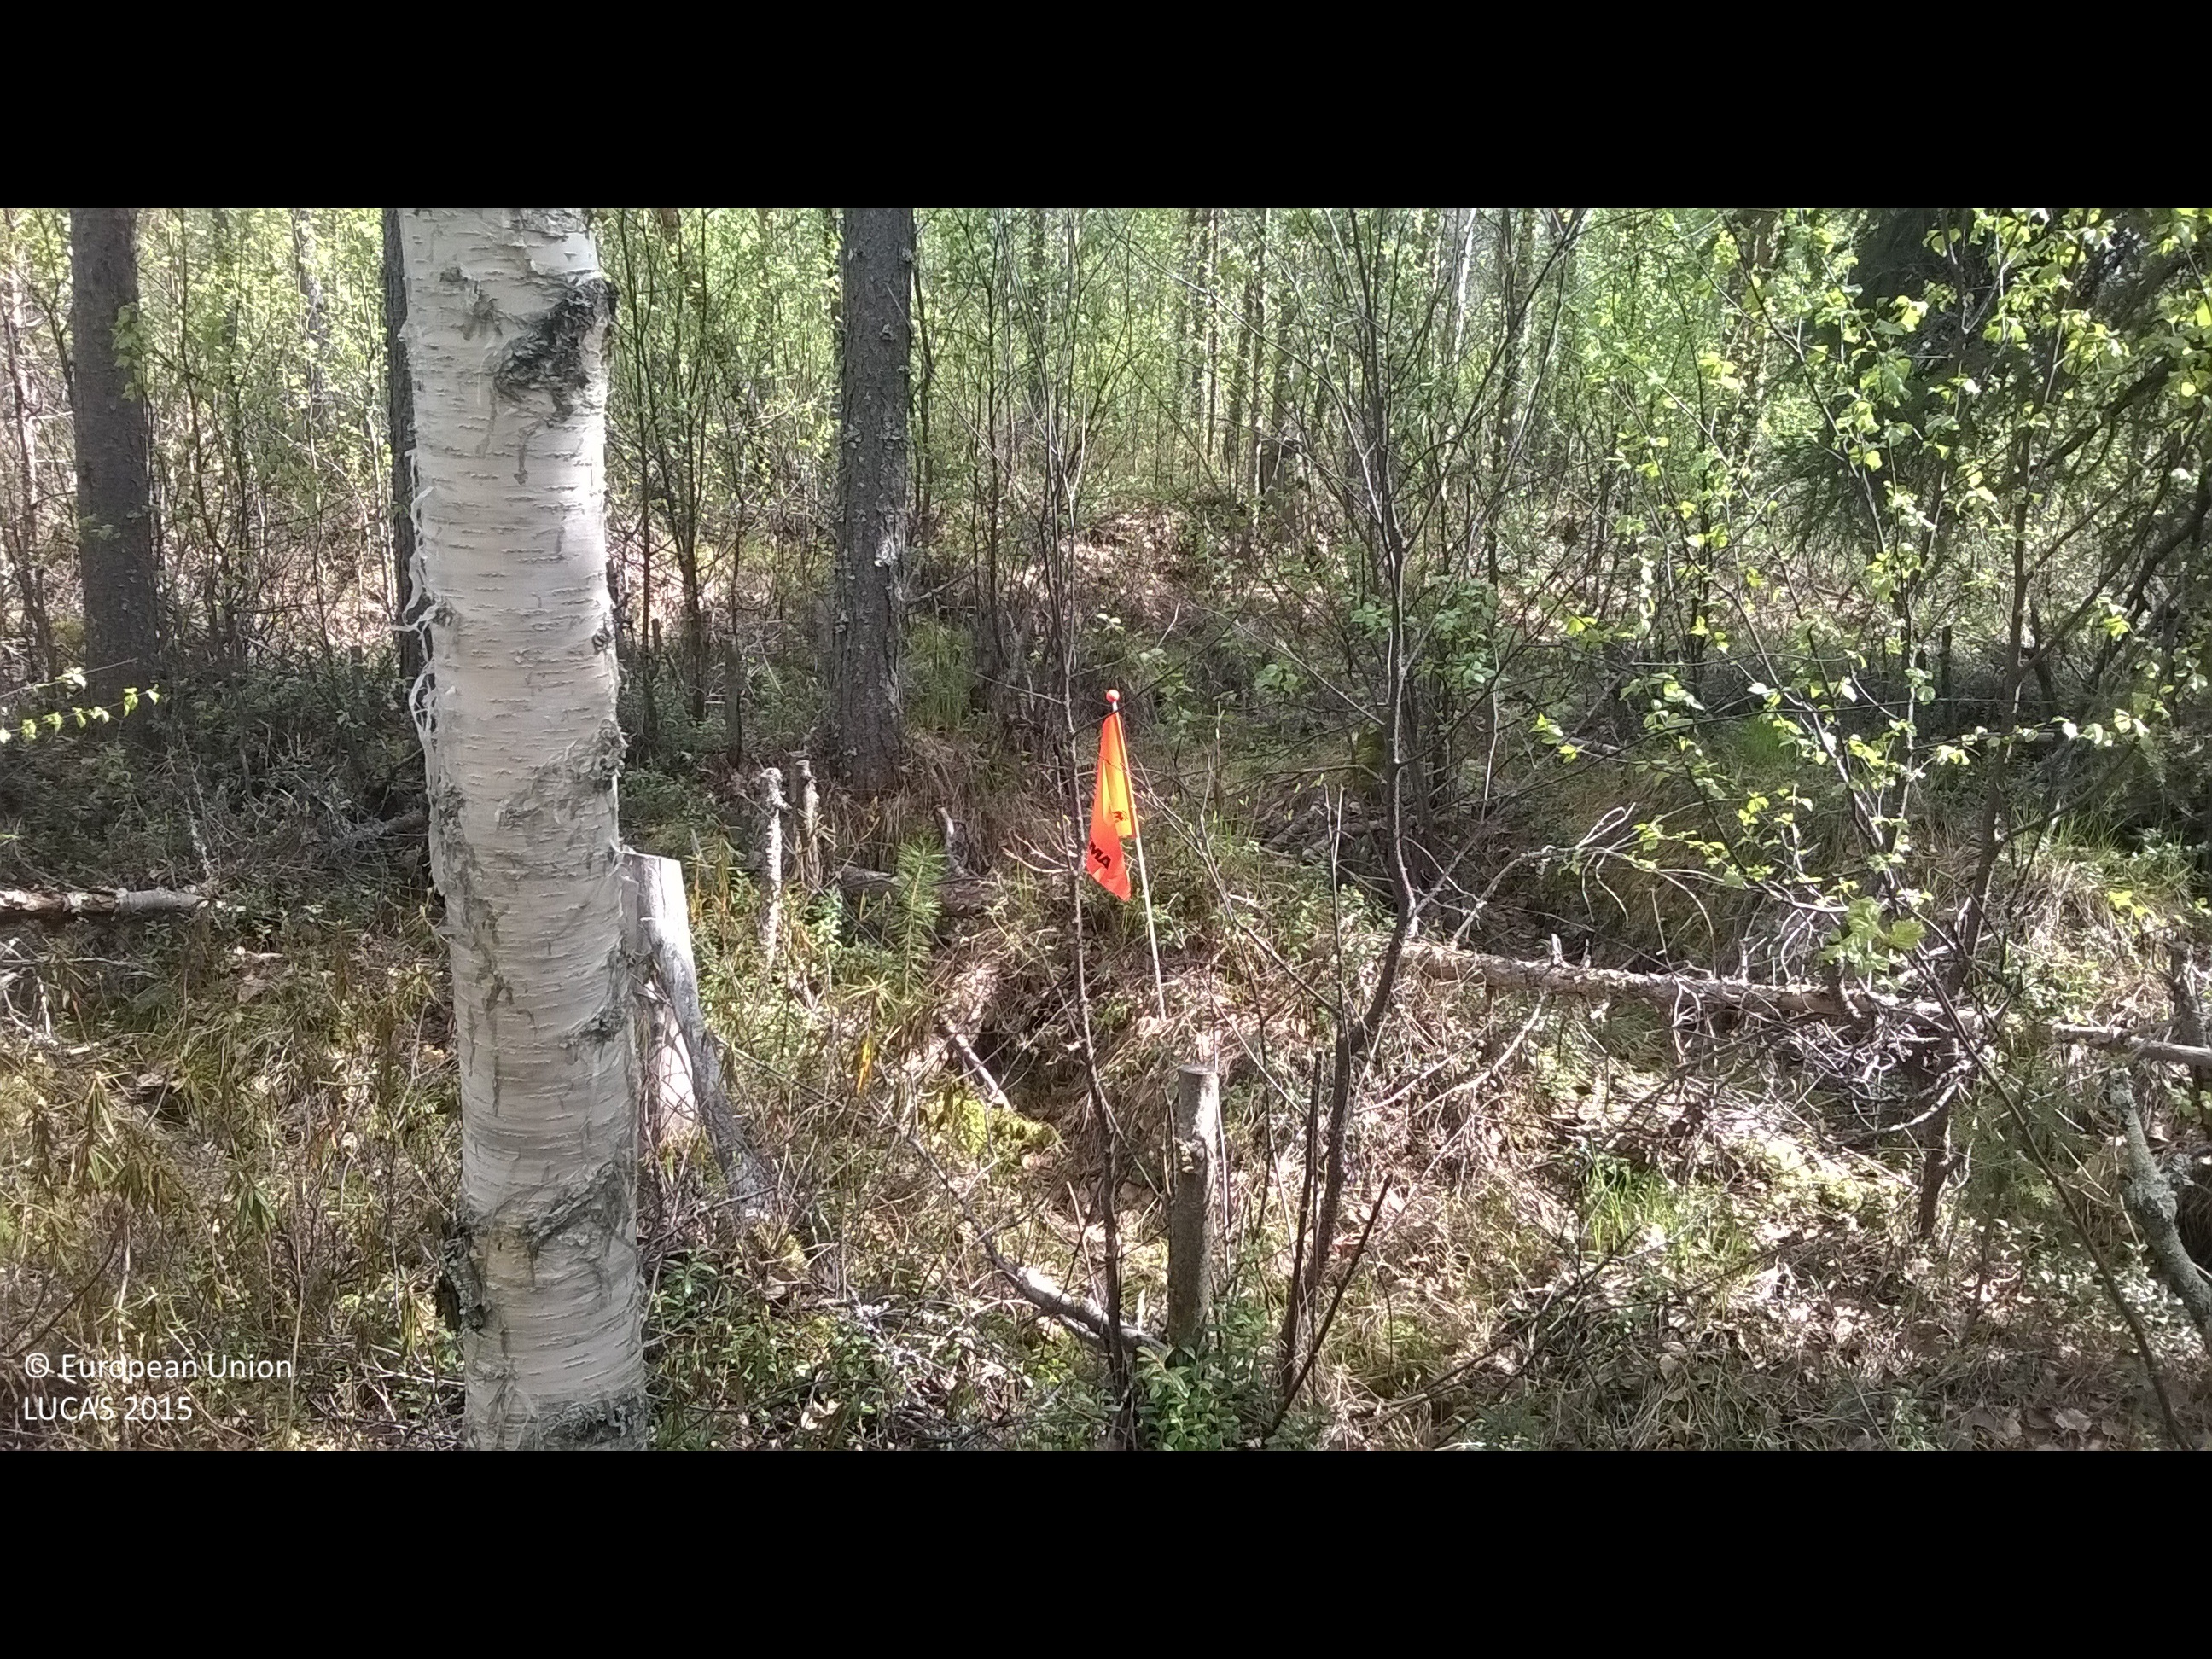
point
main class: Woodland
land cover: Pine dominated mixed woodland
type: boreal forest
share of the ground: > 75 %
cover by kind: broadleaved forest trees 60 %, coniferous forest trees 35 %, shrubs 5 %
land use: Forestry
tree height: > 5 m
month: June
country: FI
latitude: 66.5738
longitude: 26.4723
